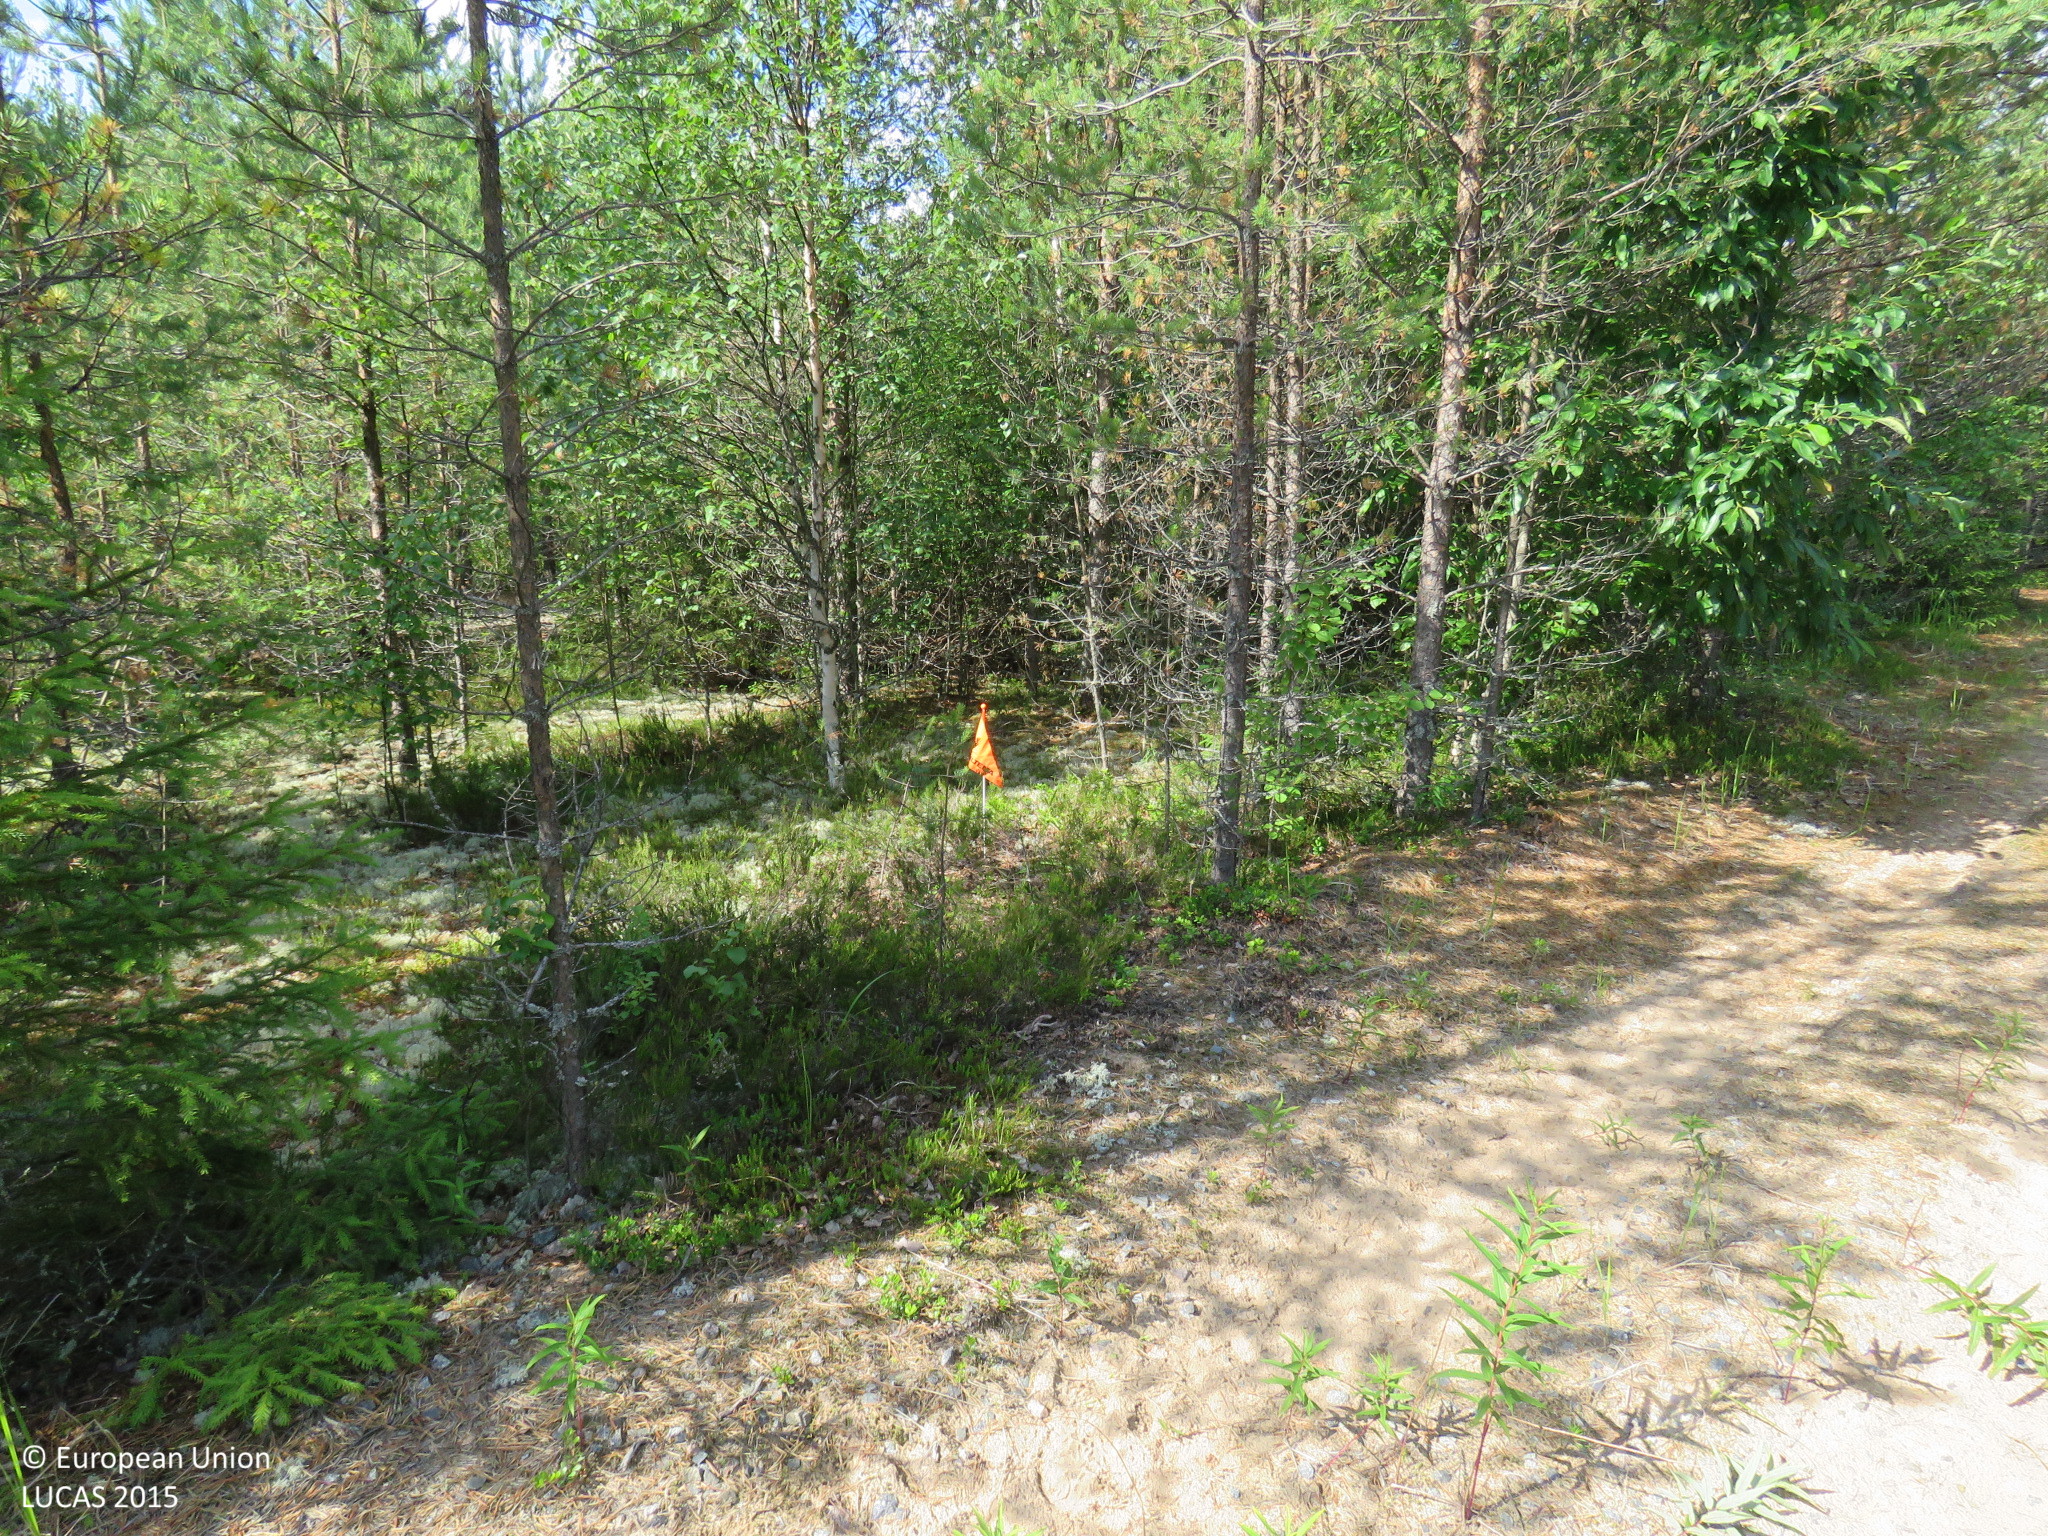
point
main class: Woodland
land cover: Other mixed woodland
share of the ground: > 75 %
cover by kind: coniferous forest trees 50 %, broadleaved forest trees 45 %, lichens and mosses 5 %
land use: Road transport
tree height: > 5 m
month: July
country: FI
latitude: 64.5648
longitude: 26.6664
